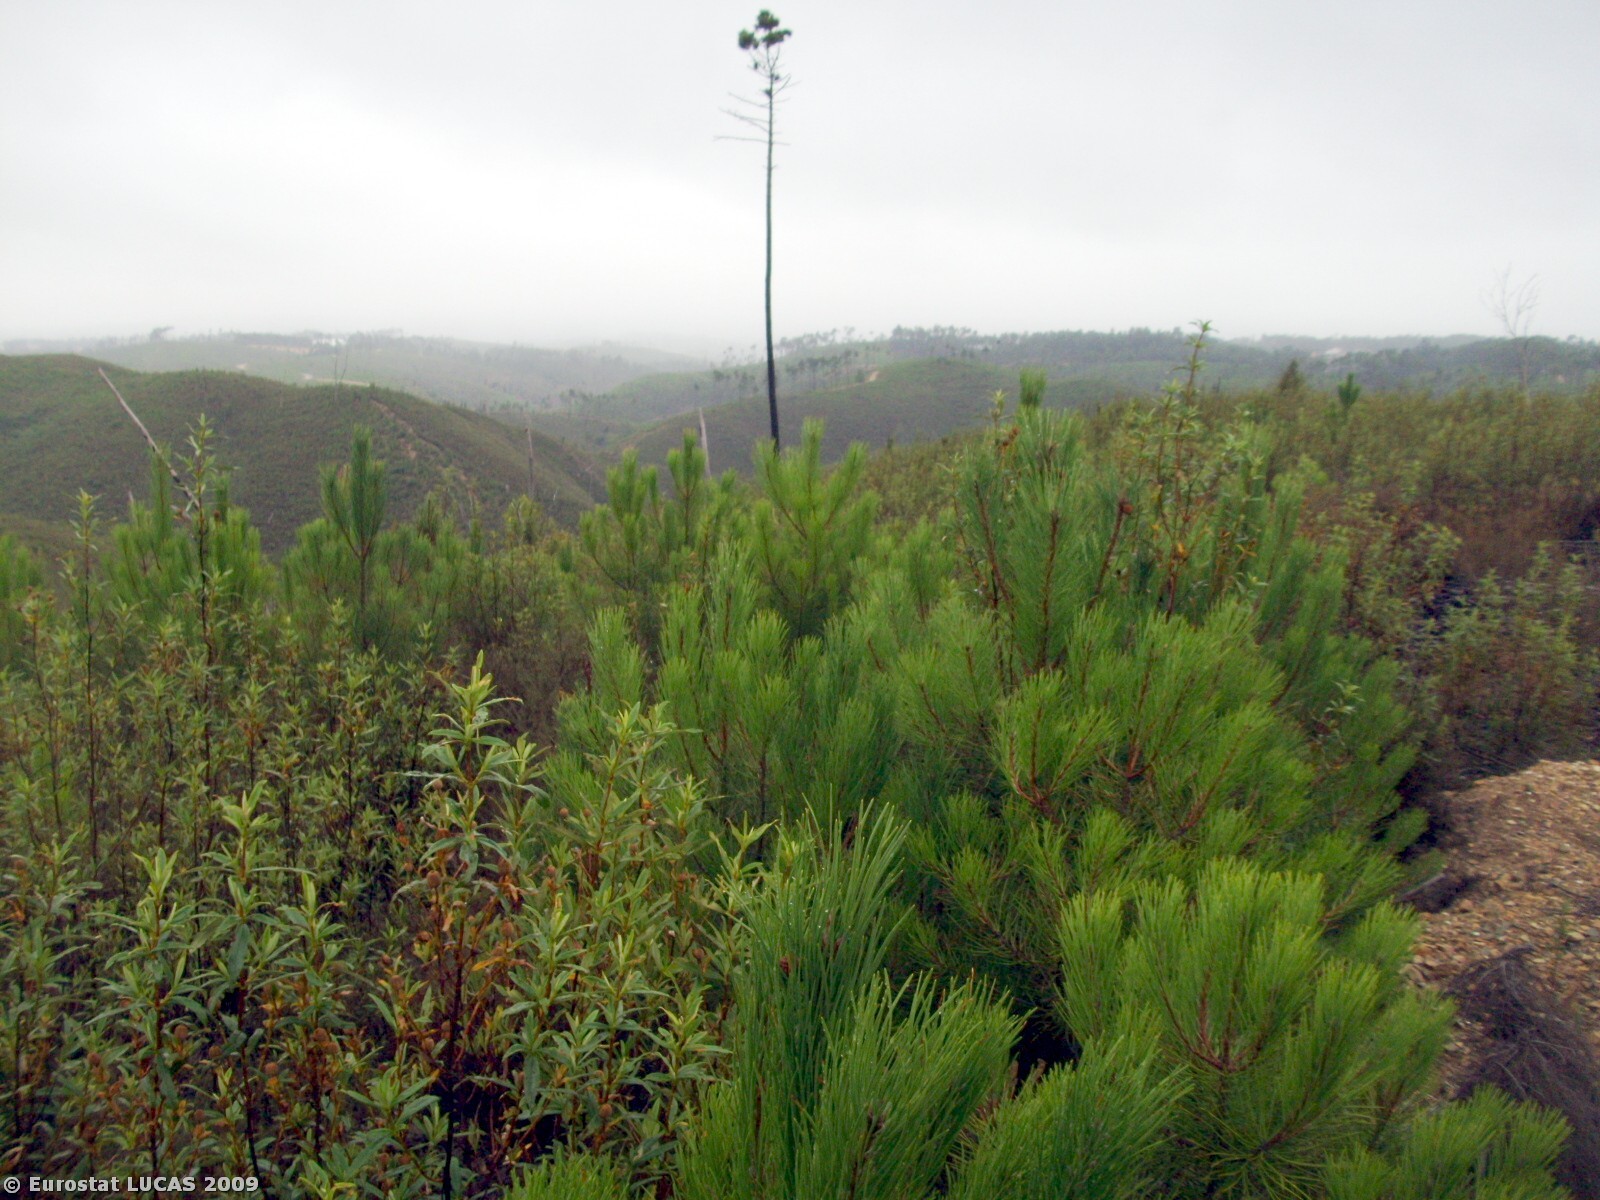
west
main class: Shrubland
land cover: Shrubland with sparse tree cover
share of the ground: > 75 %
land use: Unused
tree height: > 5 m
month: July
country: PT
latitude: 39.7162
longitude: -8.0881
